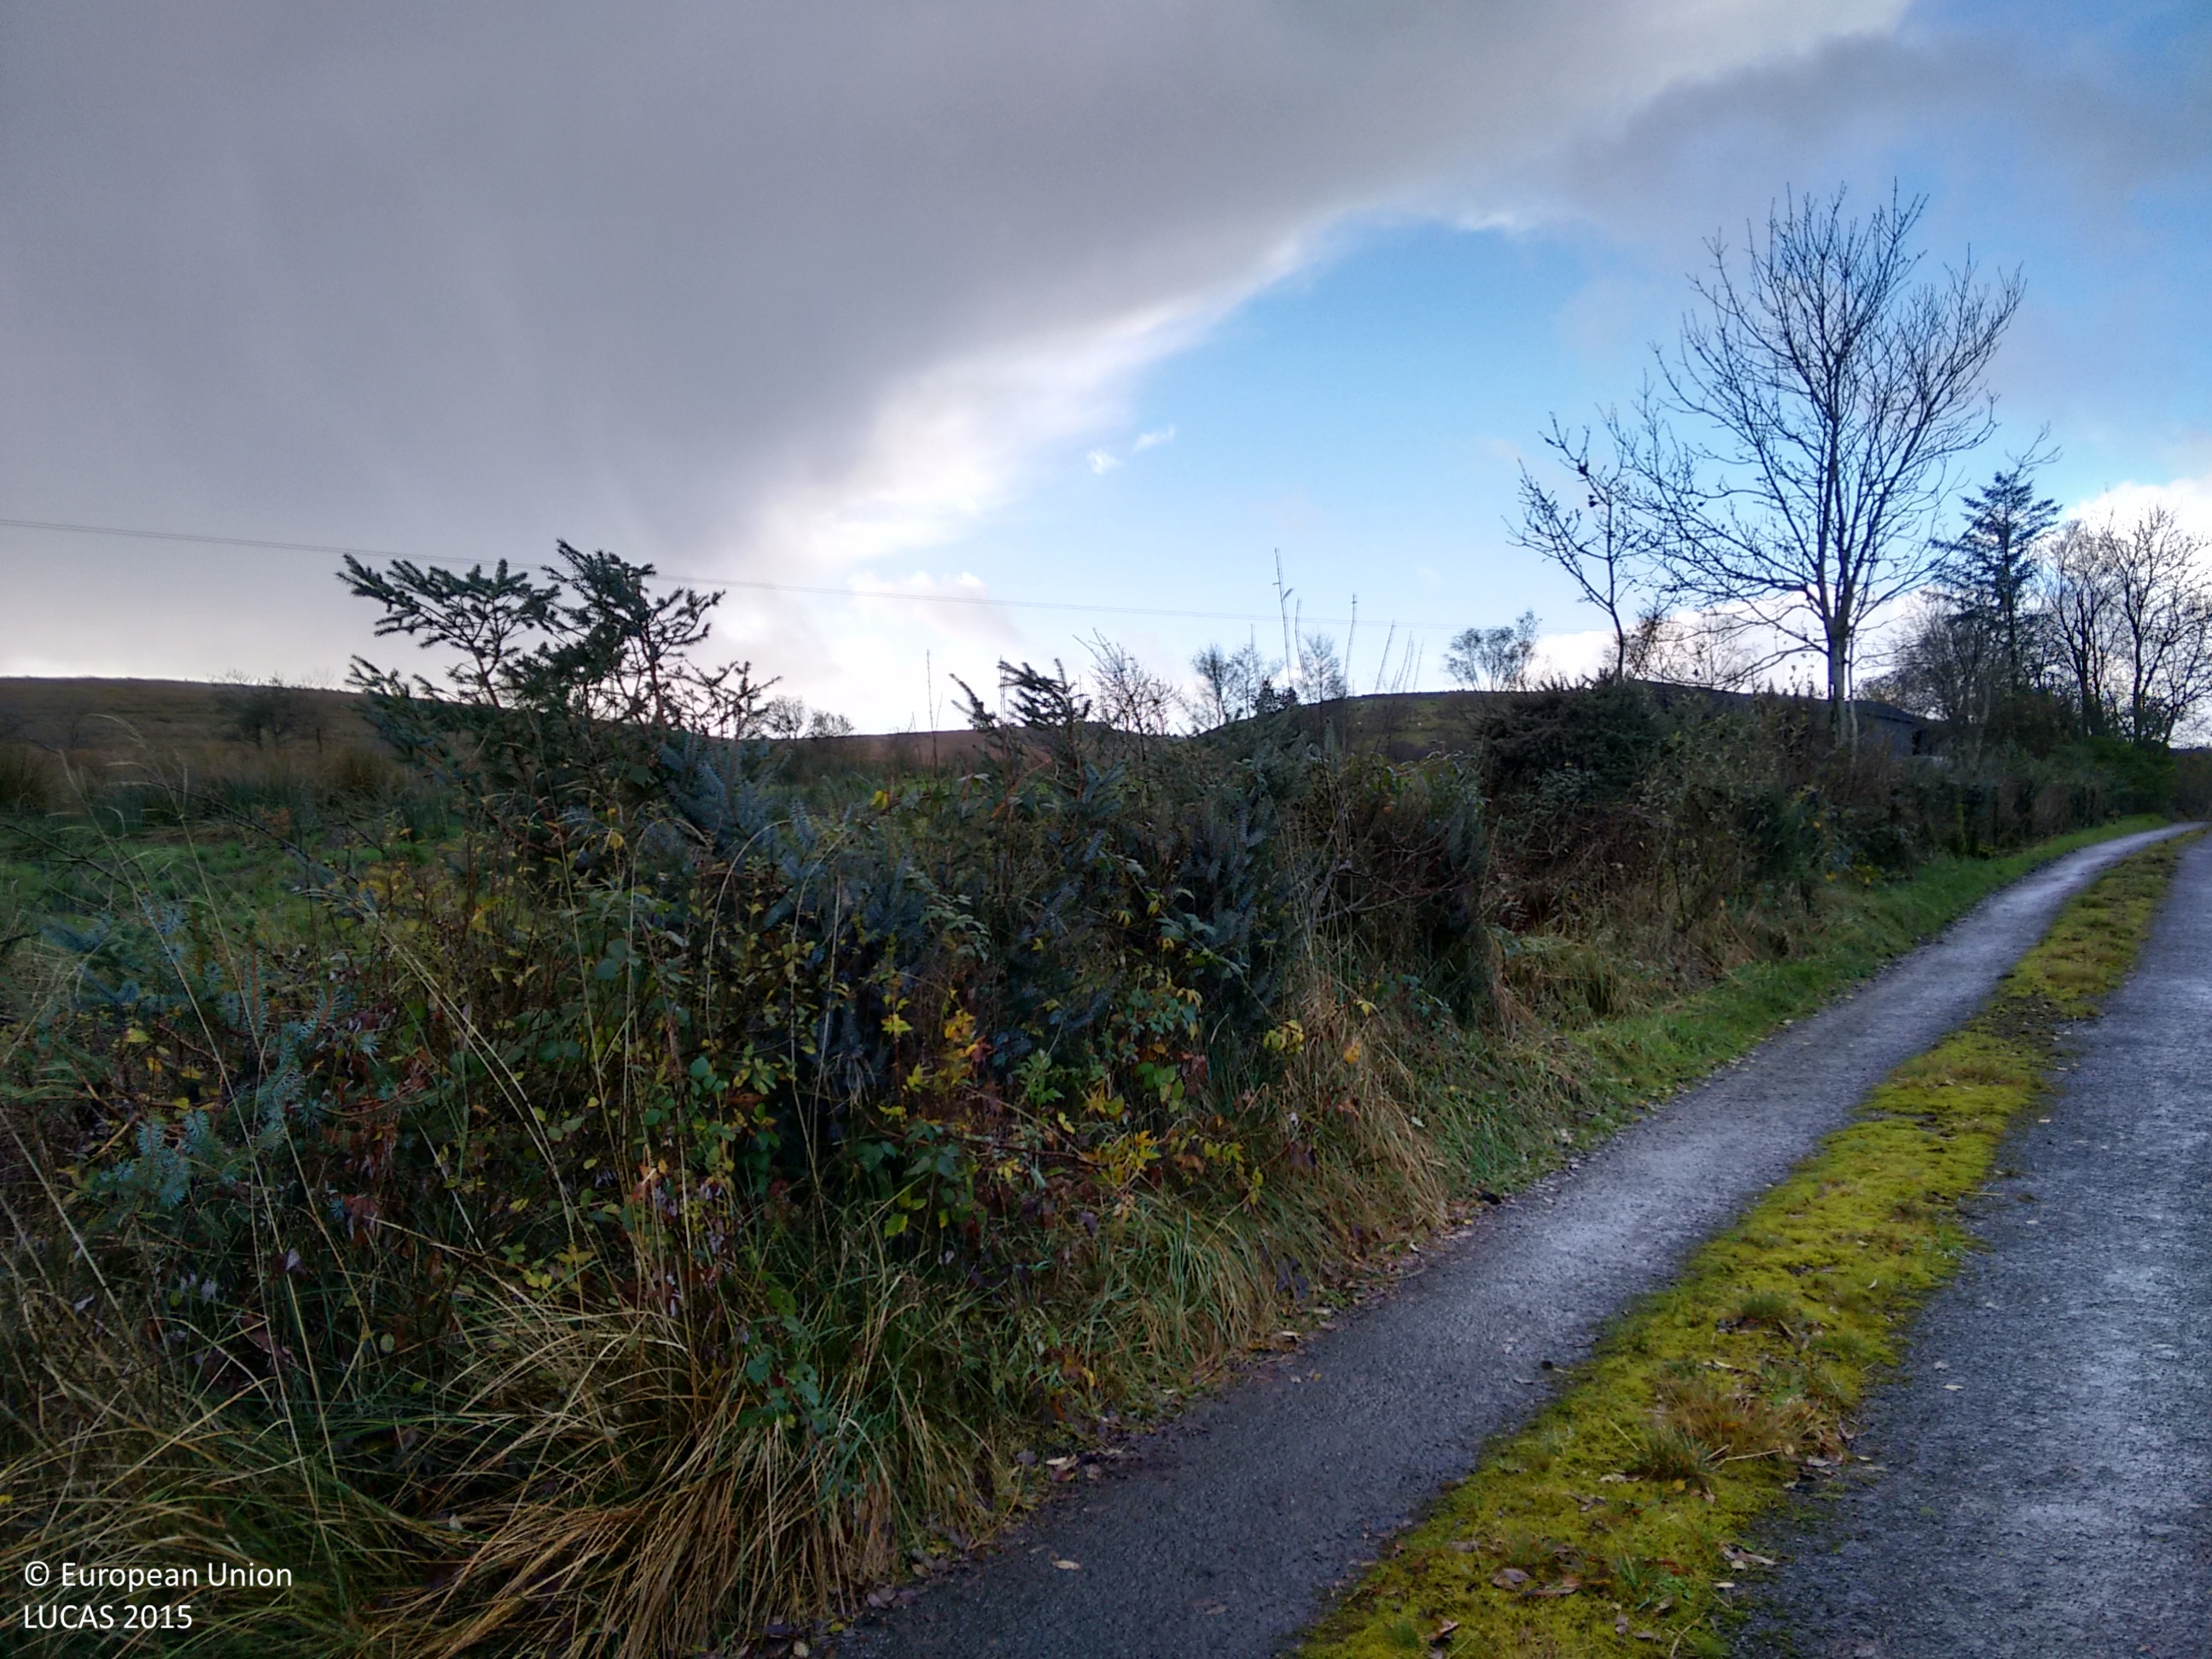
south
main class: Grassland
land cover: Grassland without tree/shrub cover
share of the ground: > 75 %
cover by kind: herbaceous plants 100 %
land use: Agriculture (excluding fallow land and kitchen gardens)
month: November
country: IE
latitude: 54.6899
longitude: -8.1581
